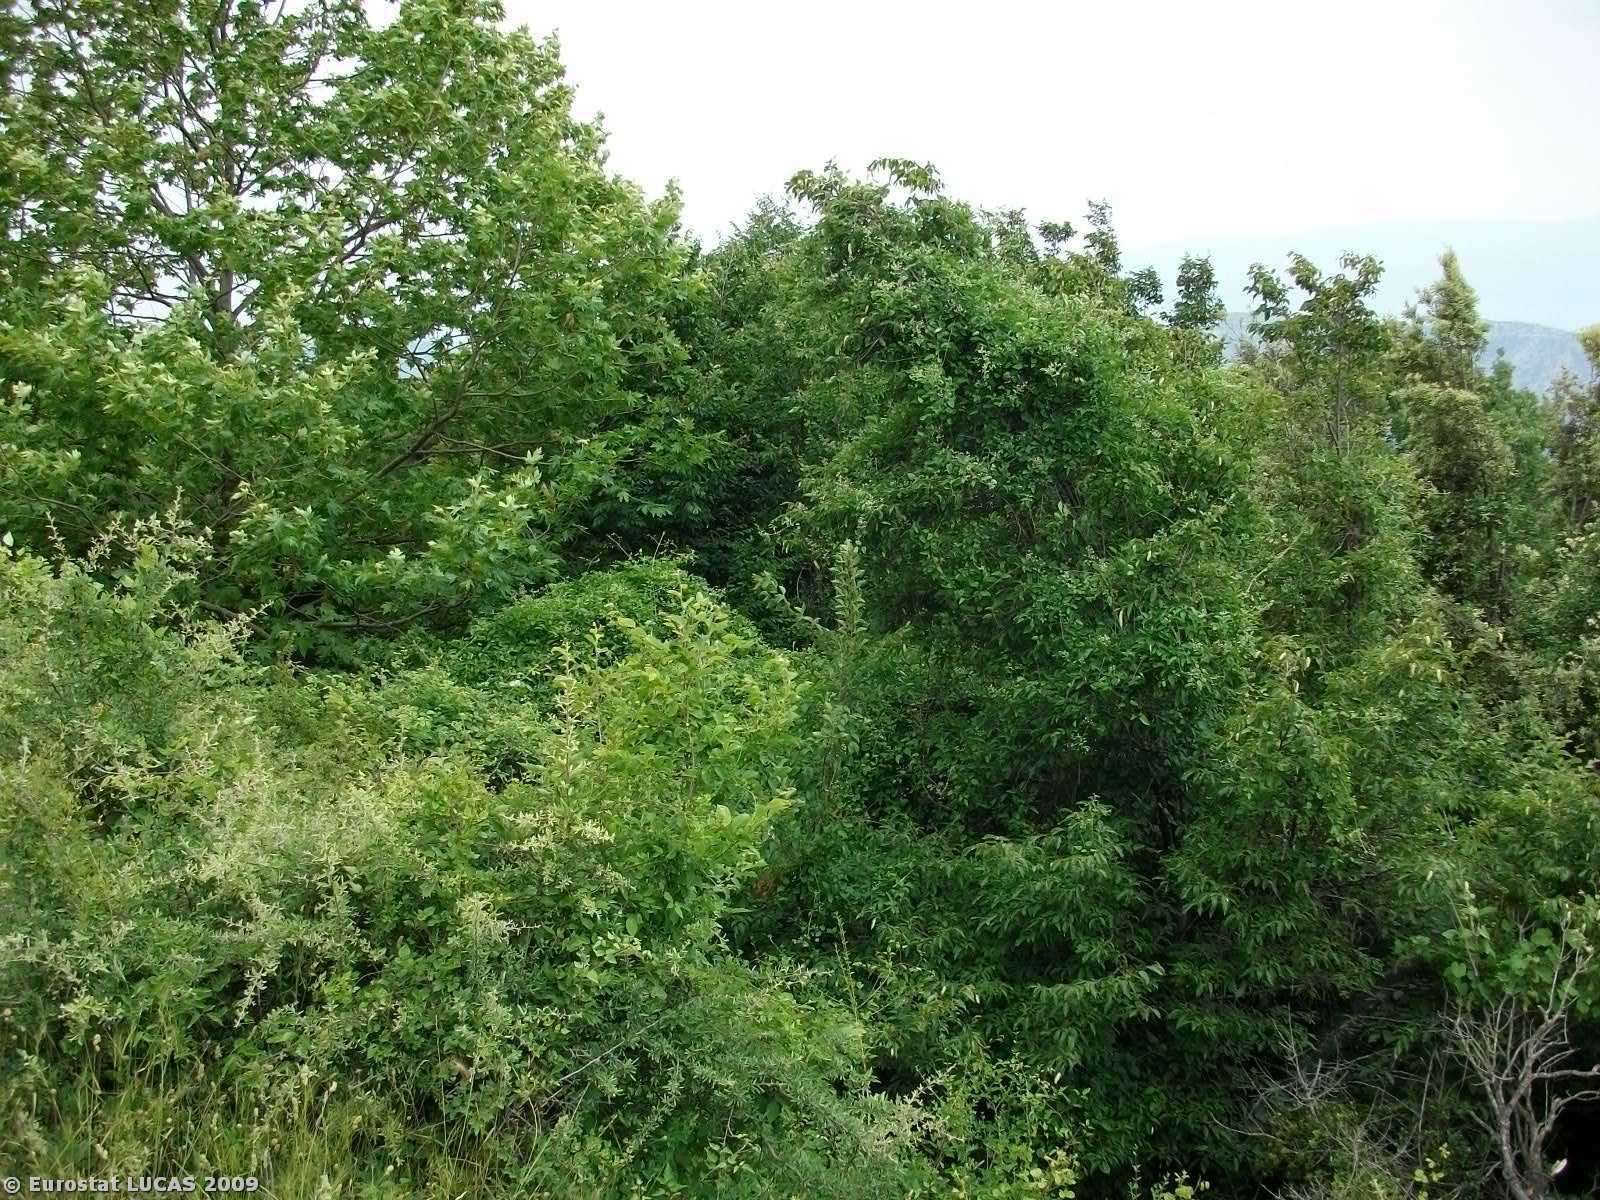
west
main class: Woodland
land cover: Broadleaved woodland
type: thermophilous deciduous forest
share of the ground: > 75 %
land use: Forestry
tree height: > 5 m
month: June
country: GR
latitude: 39.6625
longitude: 22.8039
